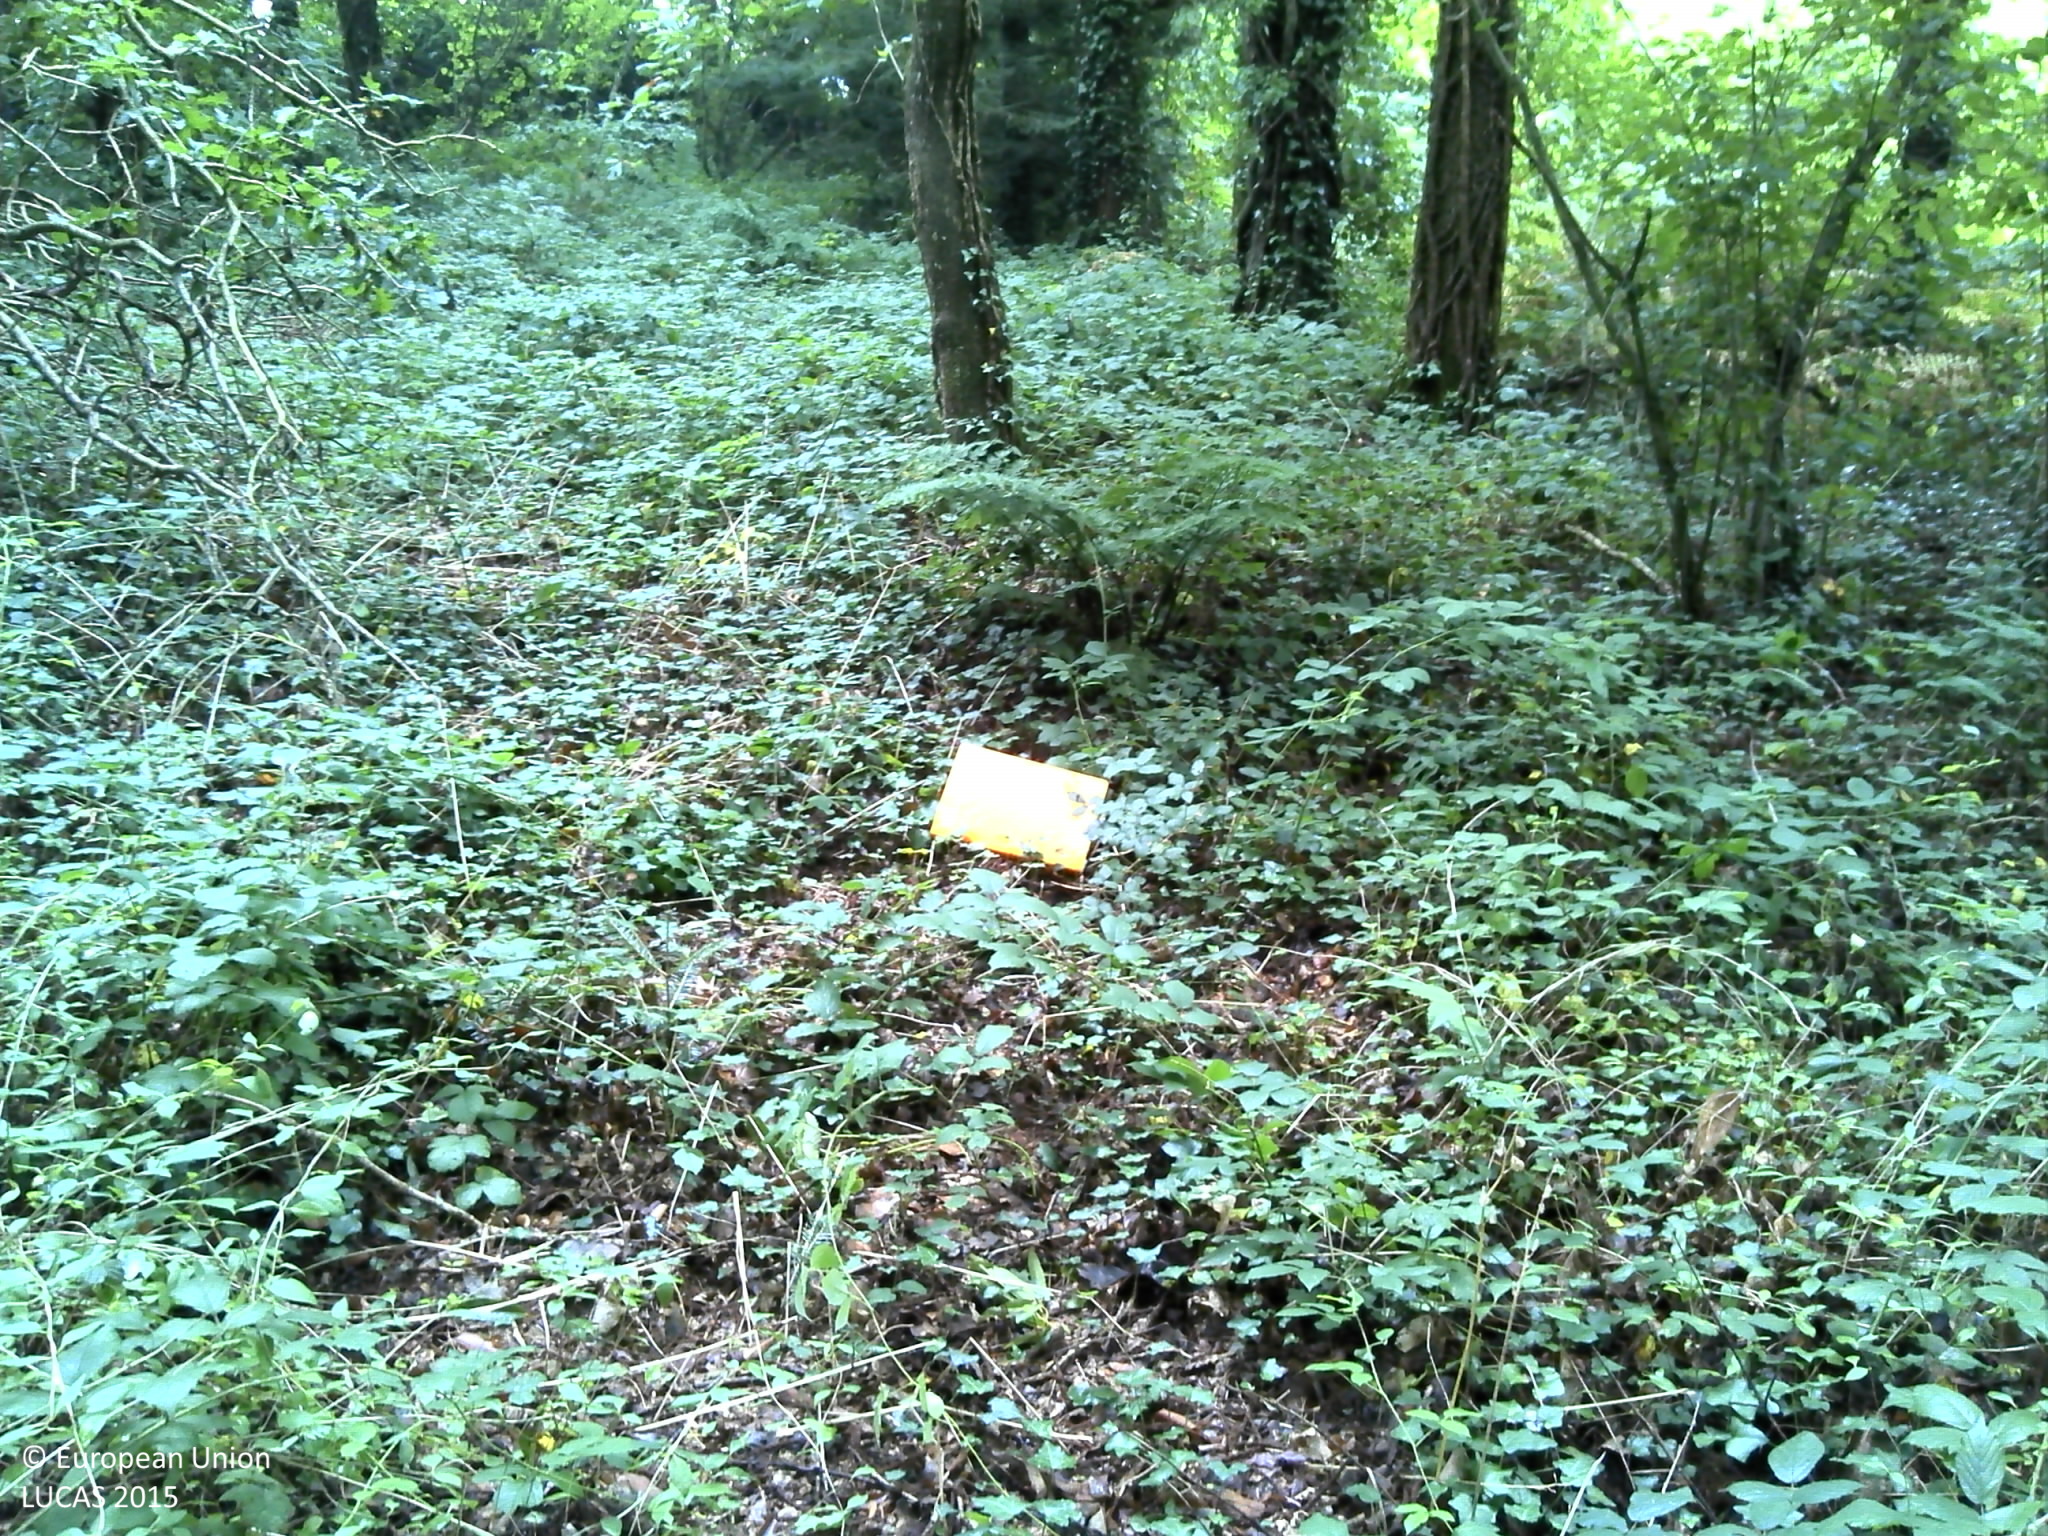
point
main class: Woodland
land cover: Broadleaved woodland
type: beech forest
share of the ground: > 75 %
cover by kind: broadleaved forest trees 100 %
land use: Forestry
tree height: > 5 m
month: August
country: FR
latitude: 48.4821
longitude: -4.5075
